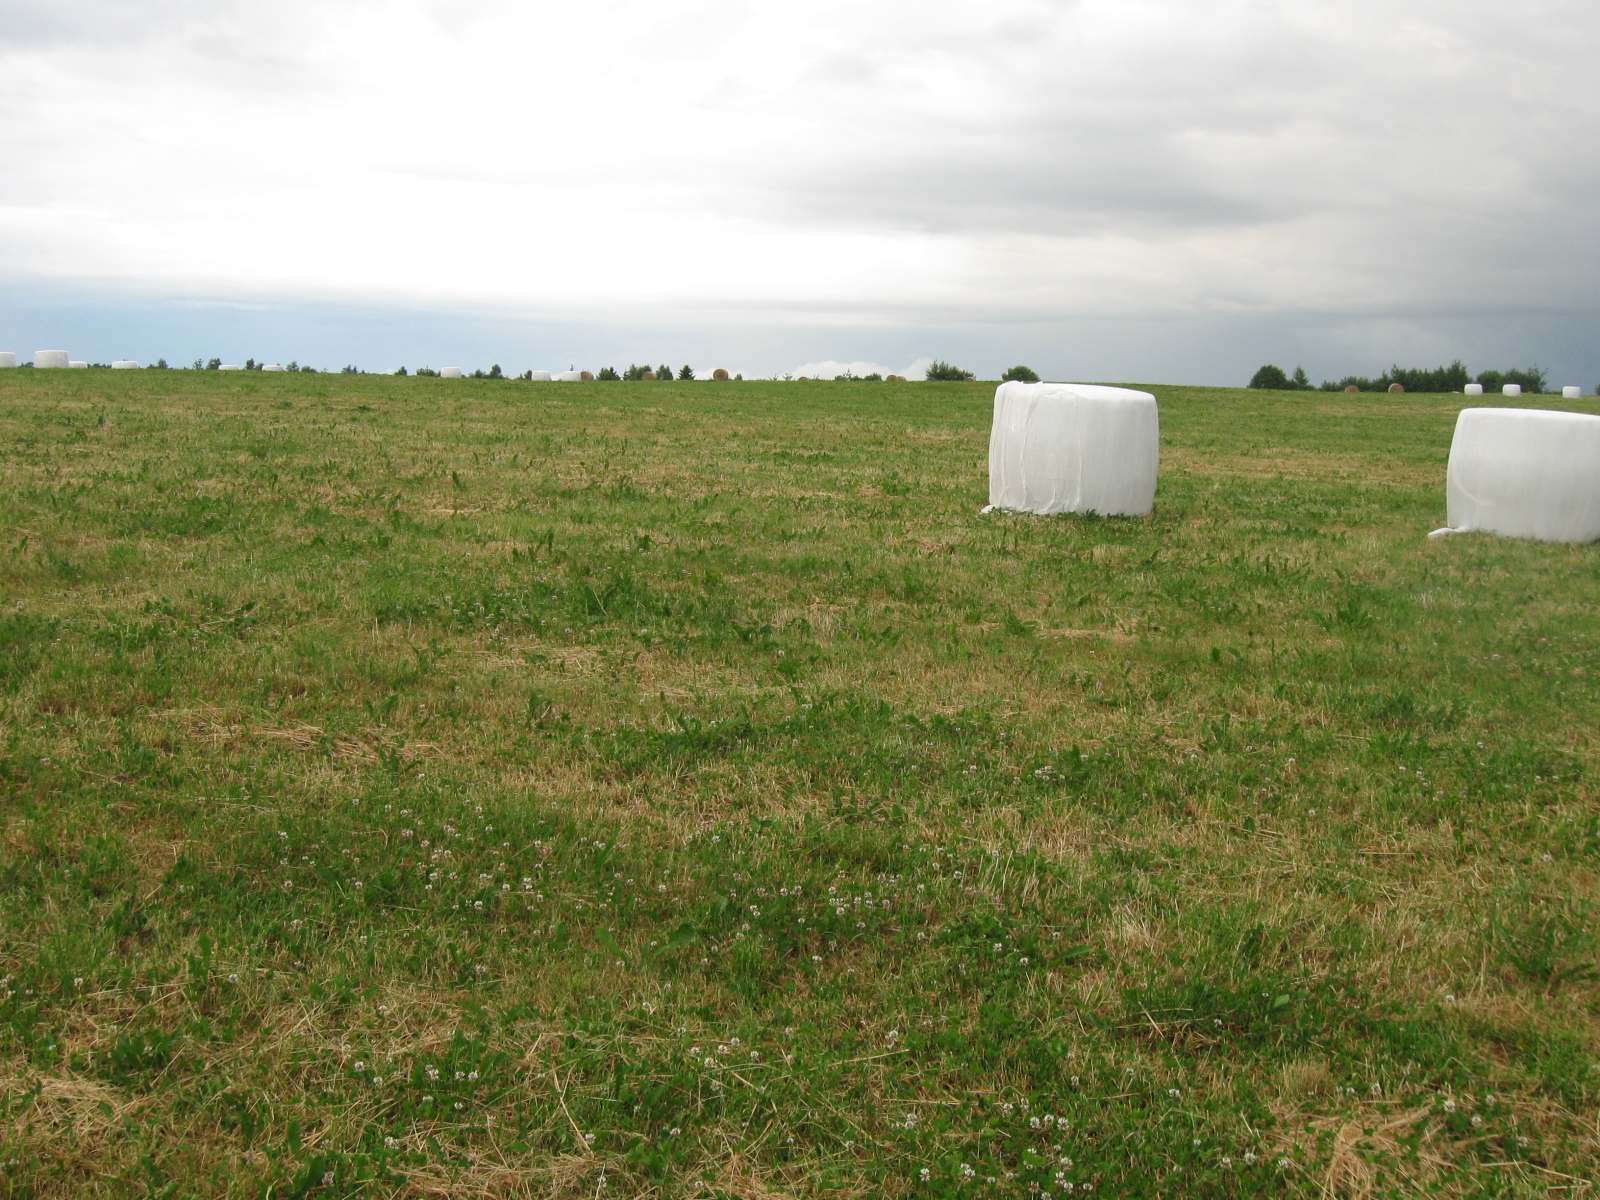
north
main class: Grassland
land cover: Grassland without tree/shrub cover
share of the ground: > 75 %
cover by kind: herbaceous plants 90 %, unconsolidated bare surface 10 %
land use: Agriculture (excluding fallow land and kitchen gardens)
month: June
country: LT
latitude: 54.9257
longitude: 24.4408
